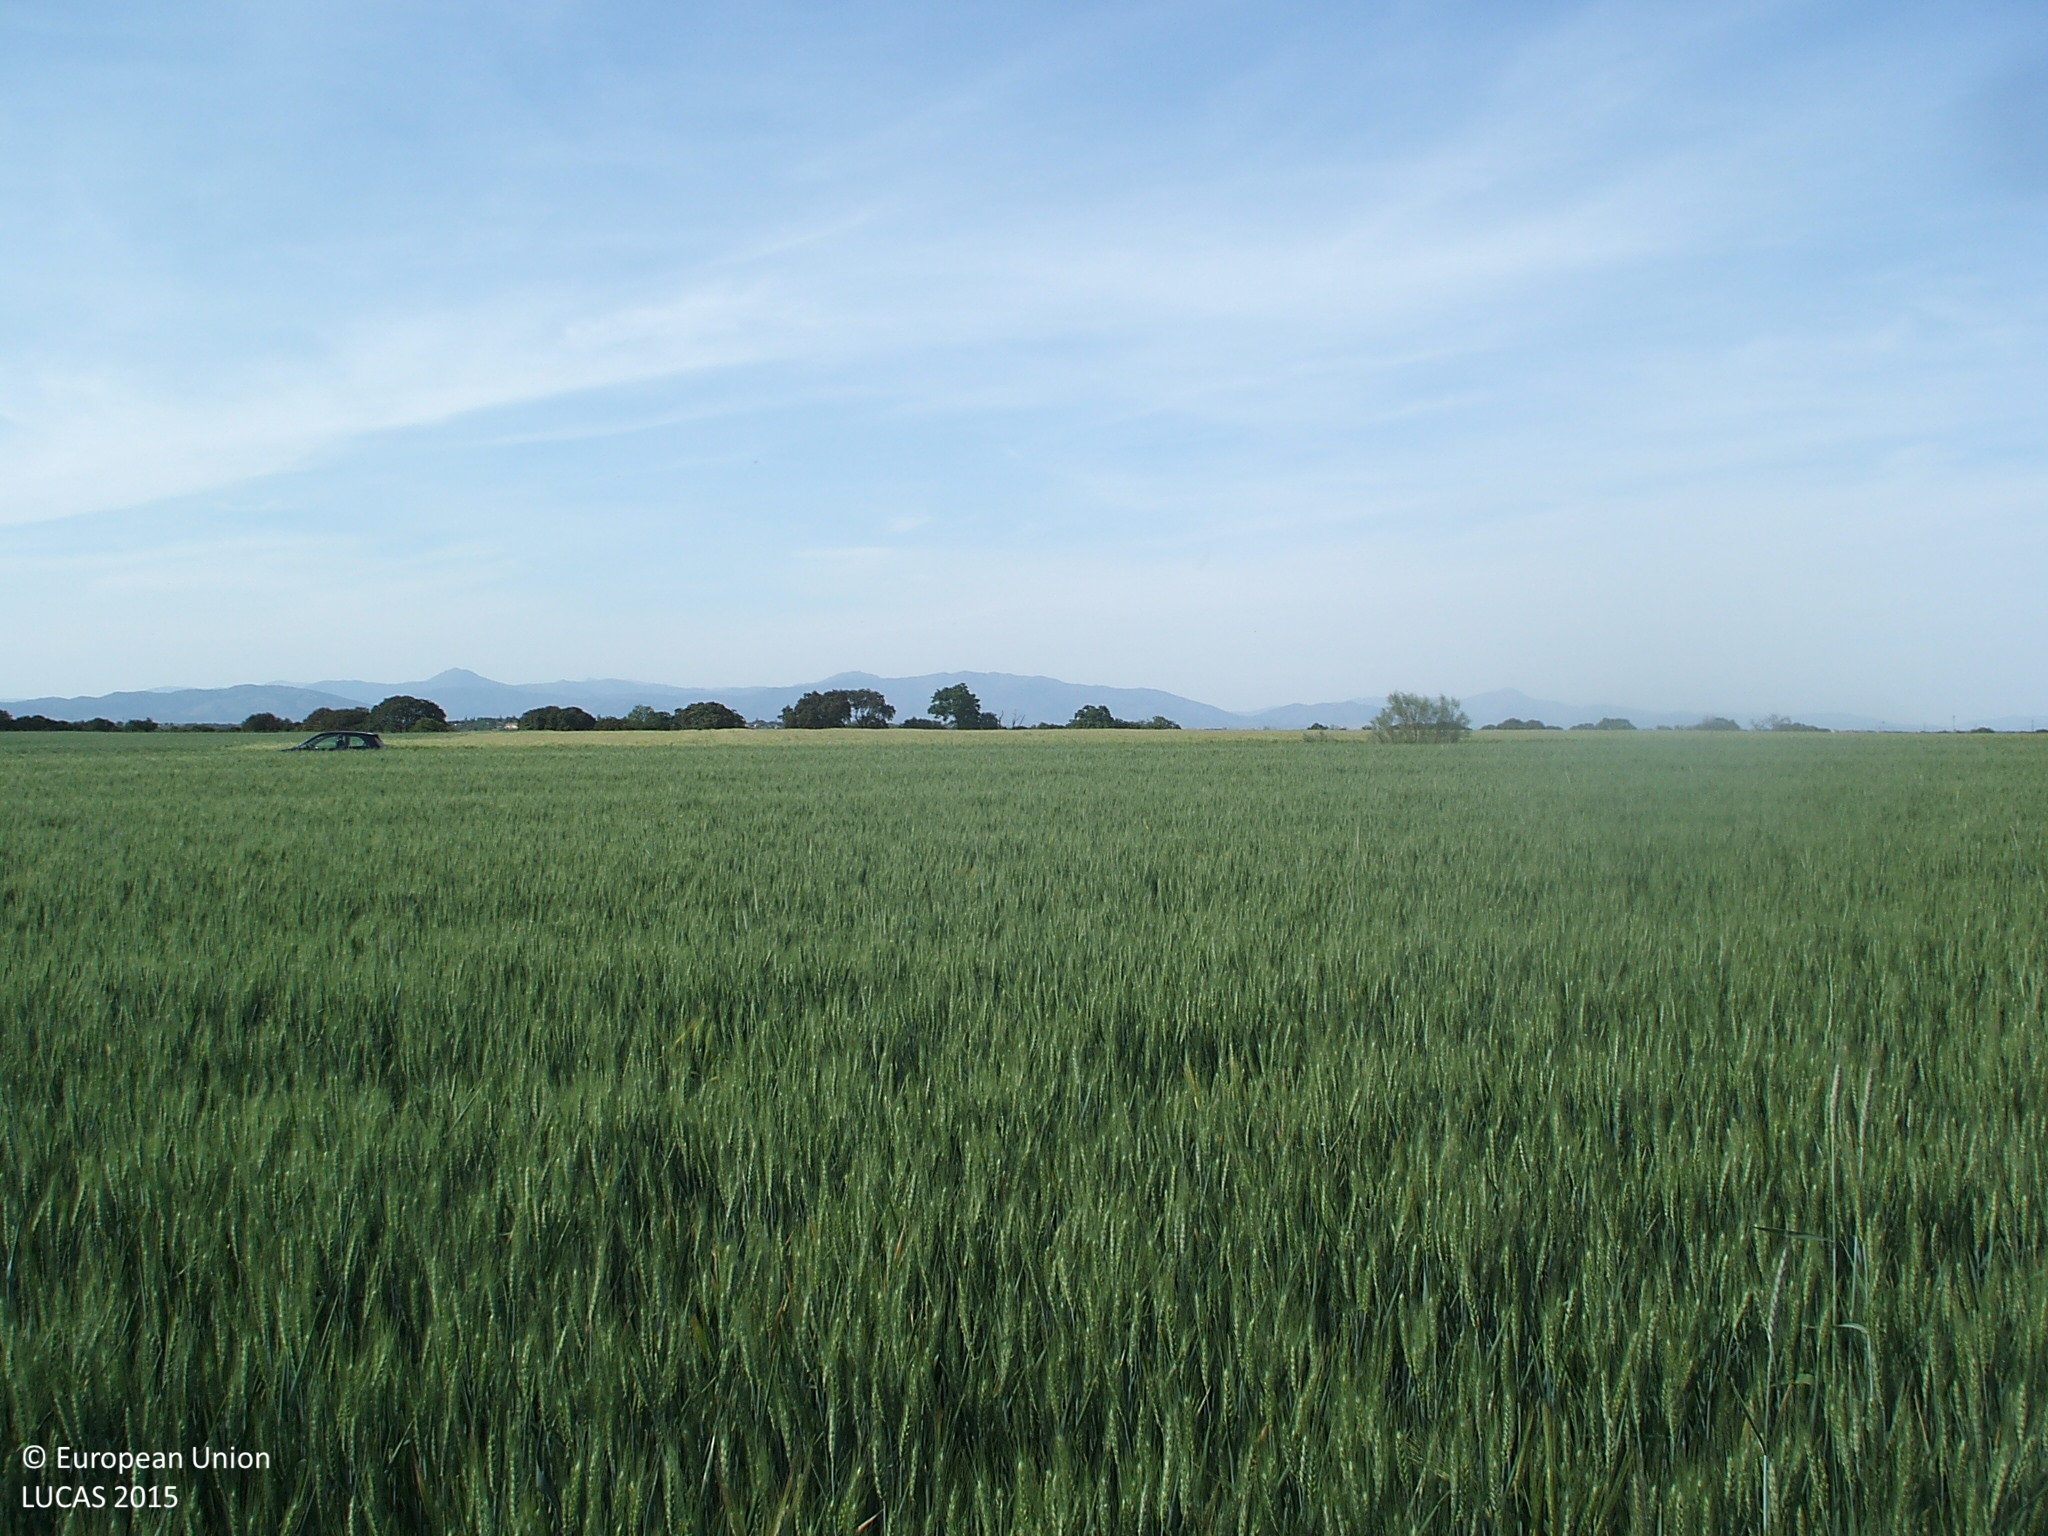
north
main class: Cropland
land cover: Common wheat
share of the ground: > 75 %
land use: Agriculture (excluding fallow land and kitchen gardens)
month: May
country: ES
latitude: 40.7308
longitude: -3.4295
